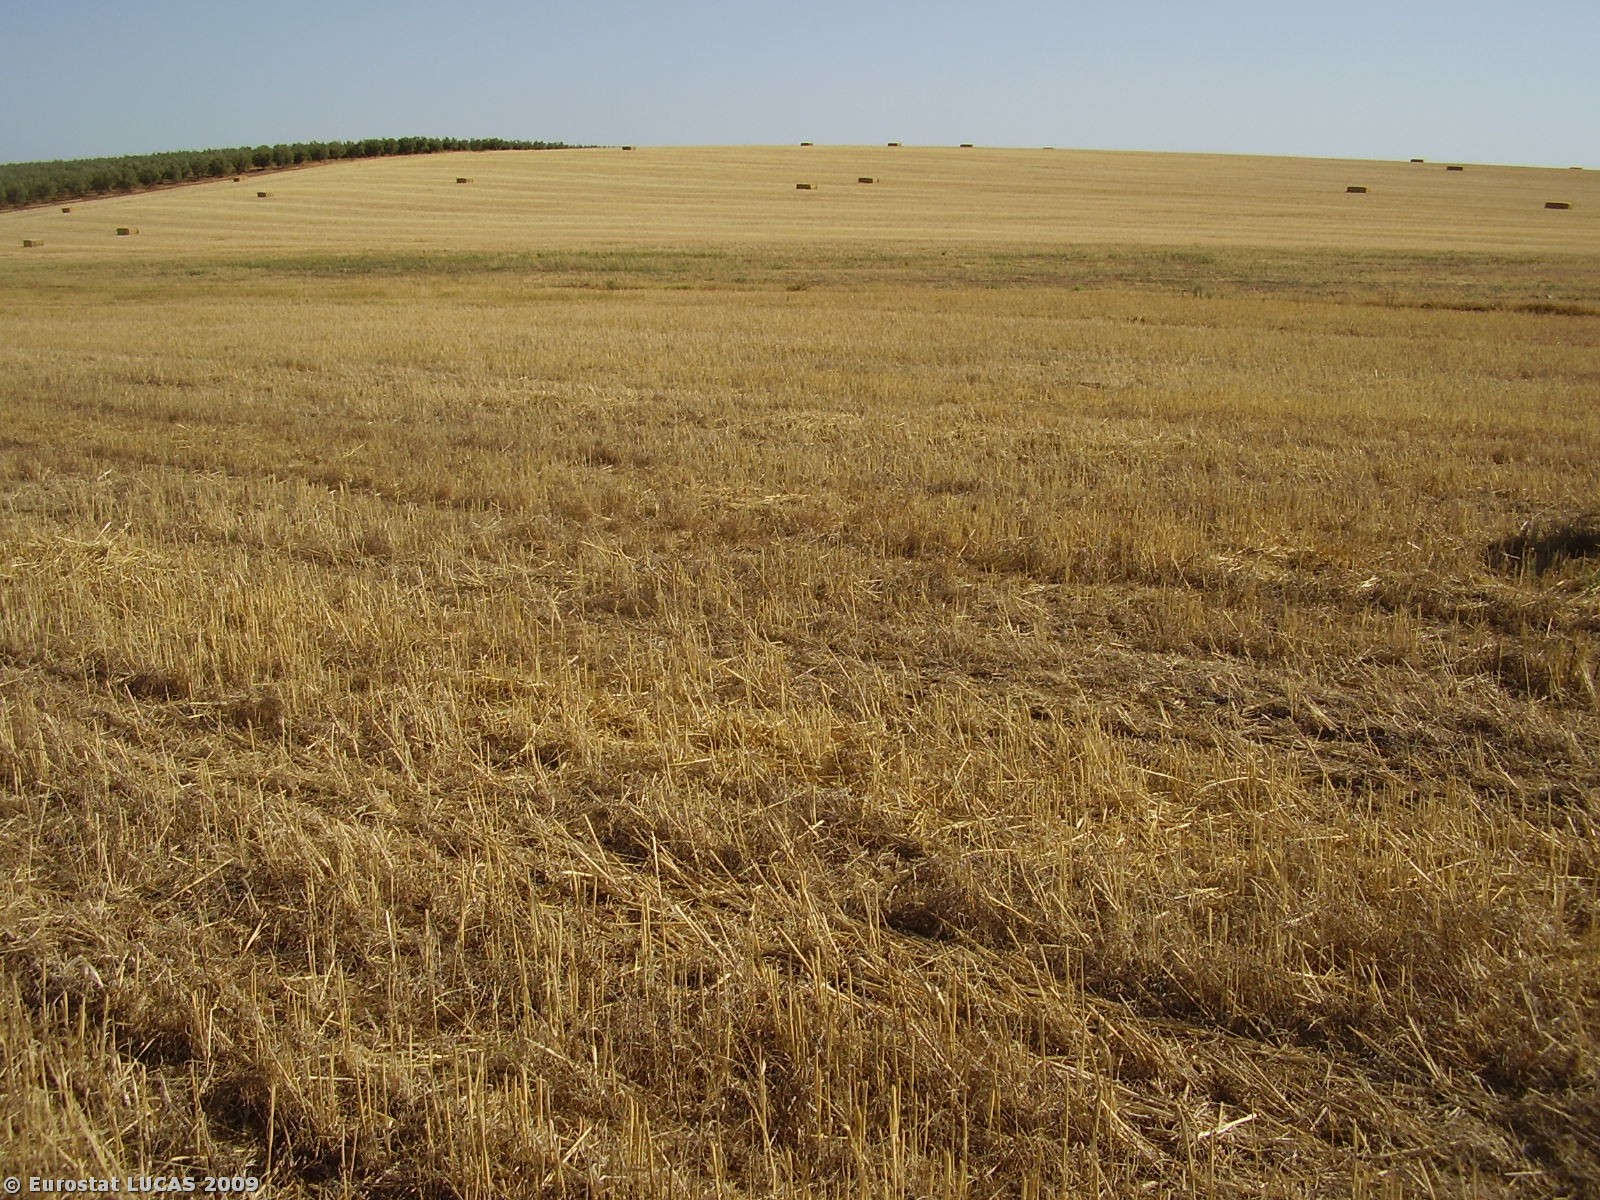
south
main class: Cropland
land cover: Common wheat
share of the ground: < 10 %
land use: Agriculture (excluding fallow land and kitchen gardens)
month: July
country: PT
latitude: 38.0169
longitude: -7.6905
